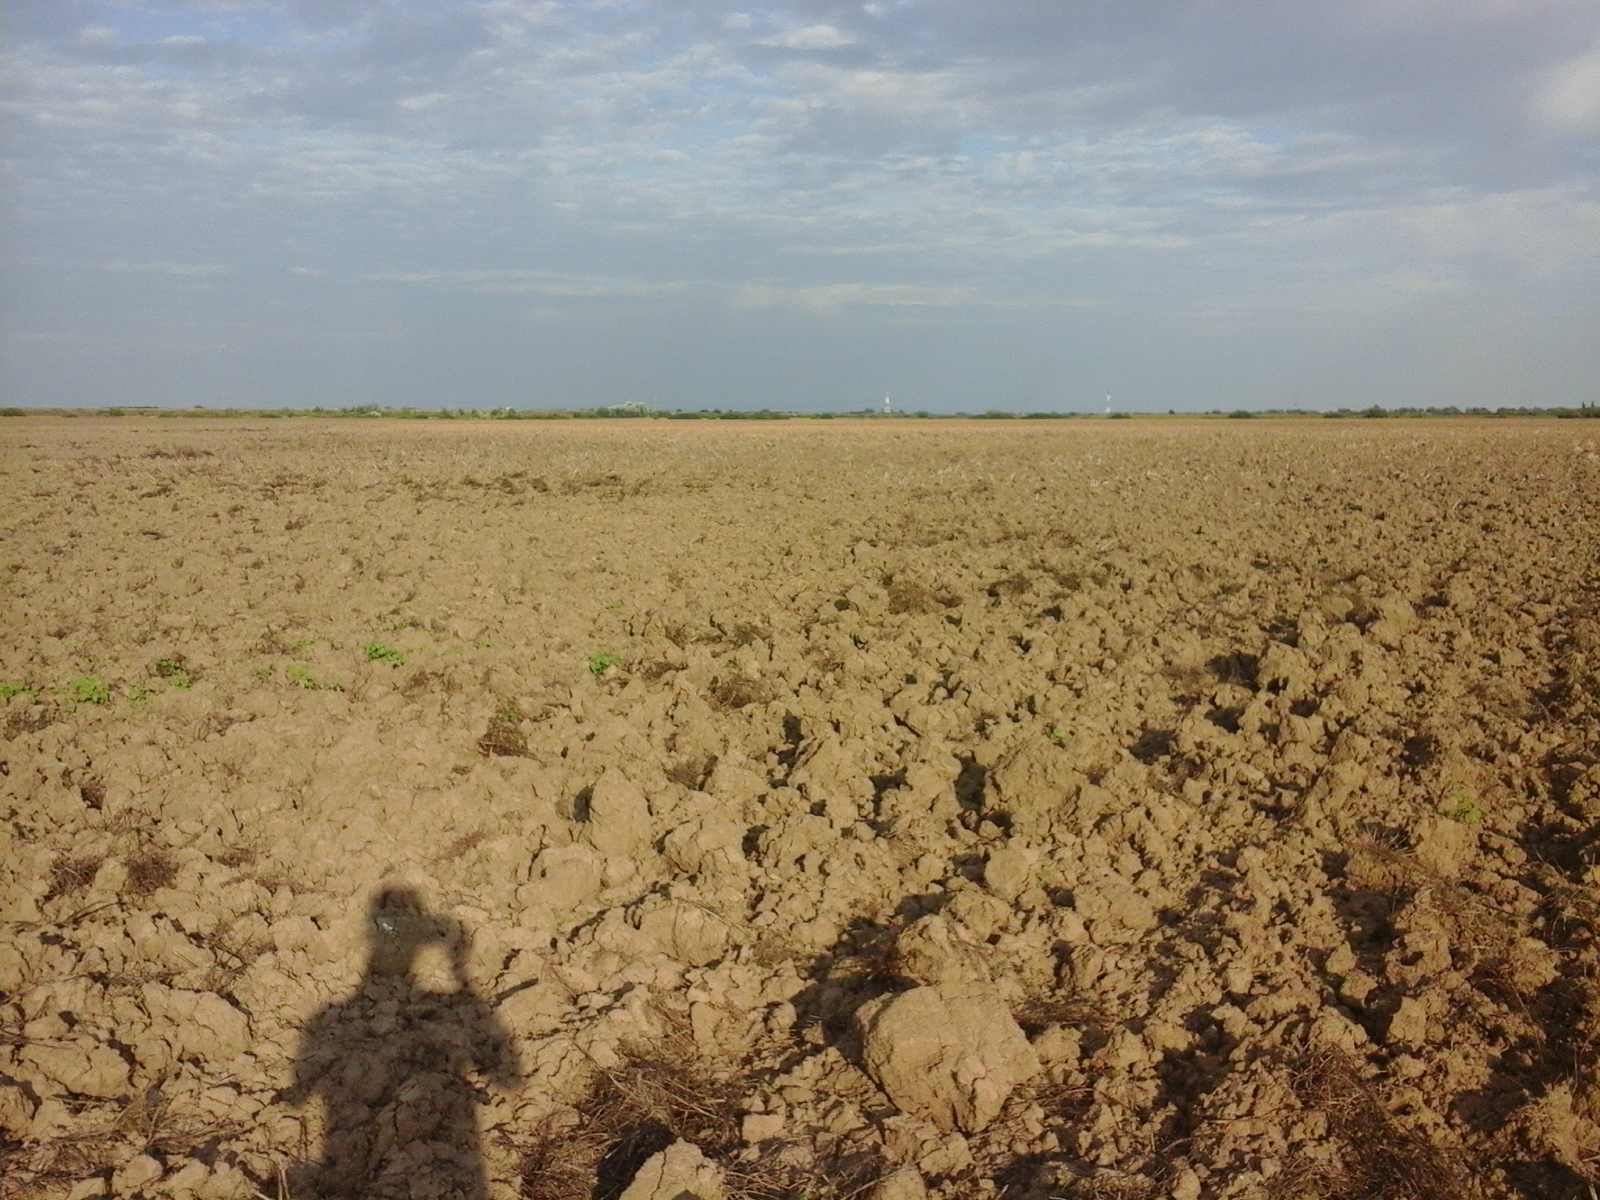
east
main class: Cropland
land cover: Rape and turnip rape
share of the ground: < 10 %
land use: Agriculture (excluding fallow land and kitchen gardens)
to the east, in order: Rape and turnip rape
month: August
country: RO
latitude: 46.6628
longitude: 21.6063
